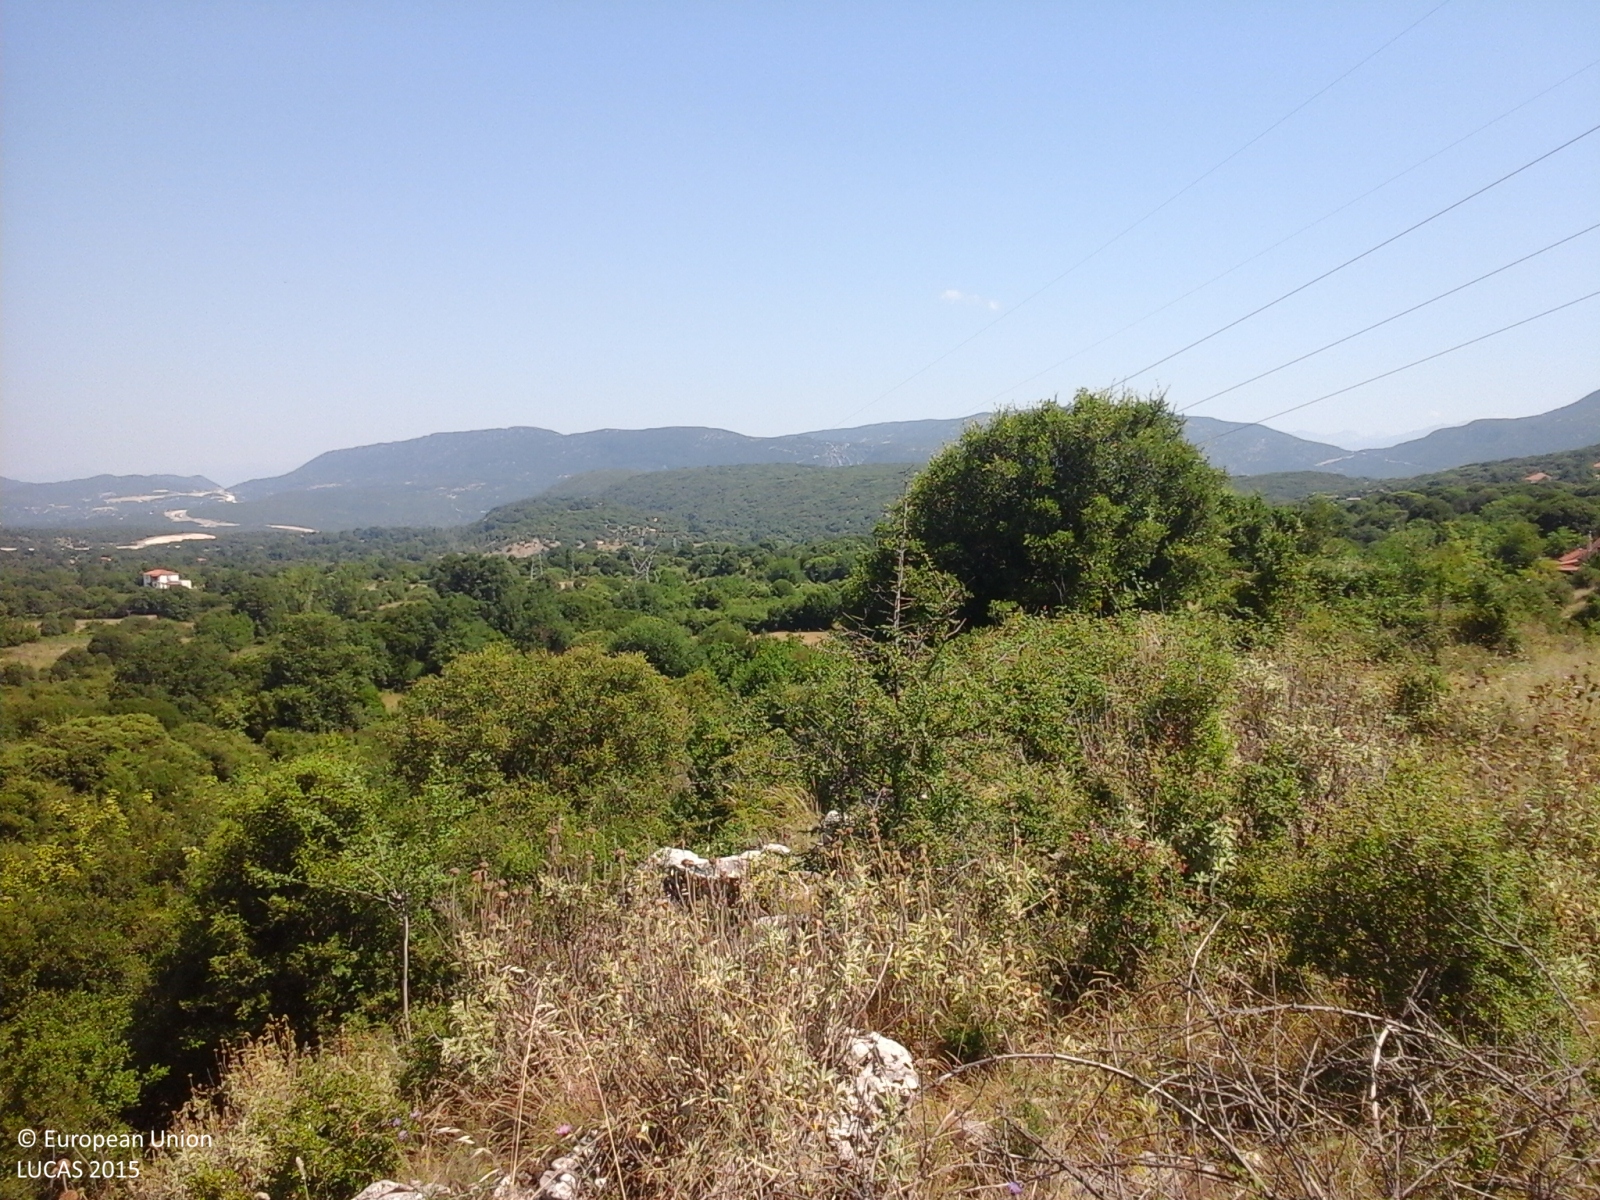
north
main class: Shrubland
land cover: Shrubland with sparse tree cover
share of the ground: > 75 %
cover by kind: shrubs 90 %, broadleaved forest trees 5 %, unconsolidated bare surface 5 %
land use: Semi-natural and natural areas not in use
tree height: < 5 m
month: July
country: GR
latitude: 39.4023
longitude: 20.9035
